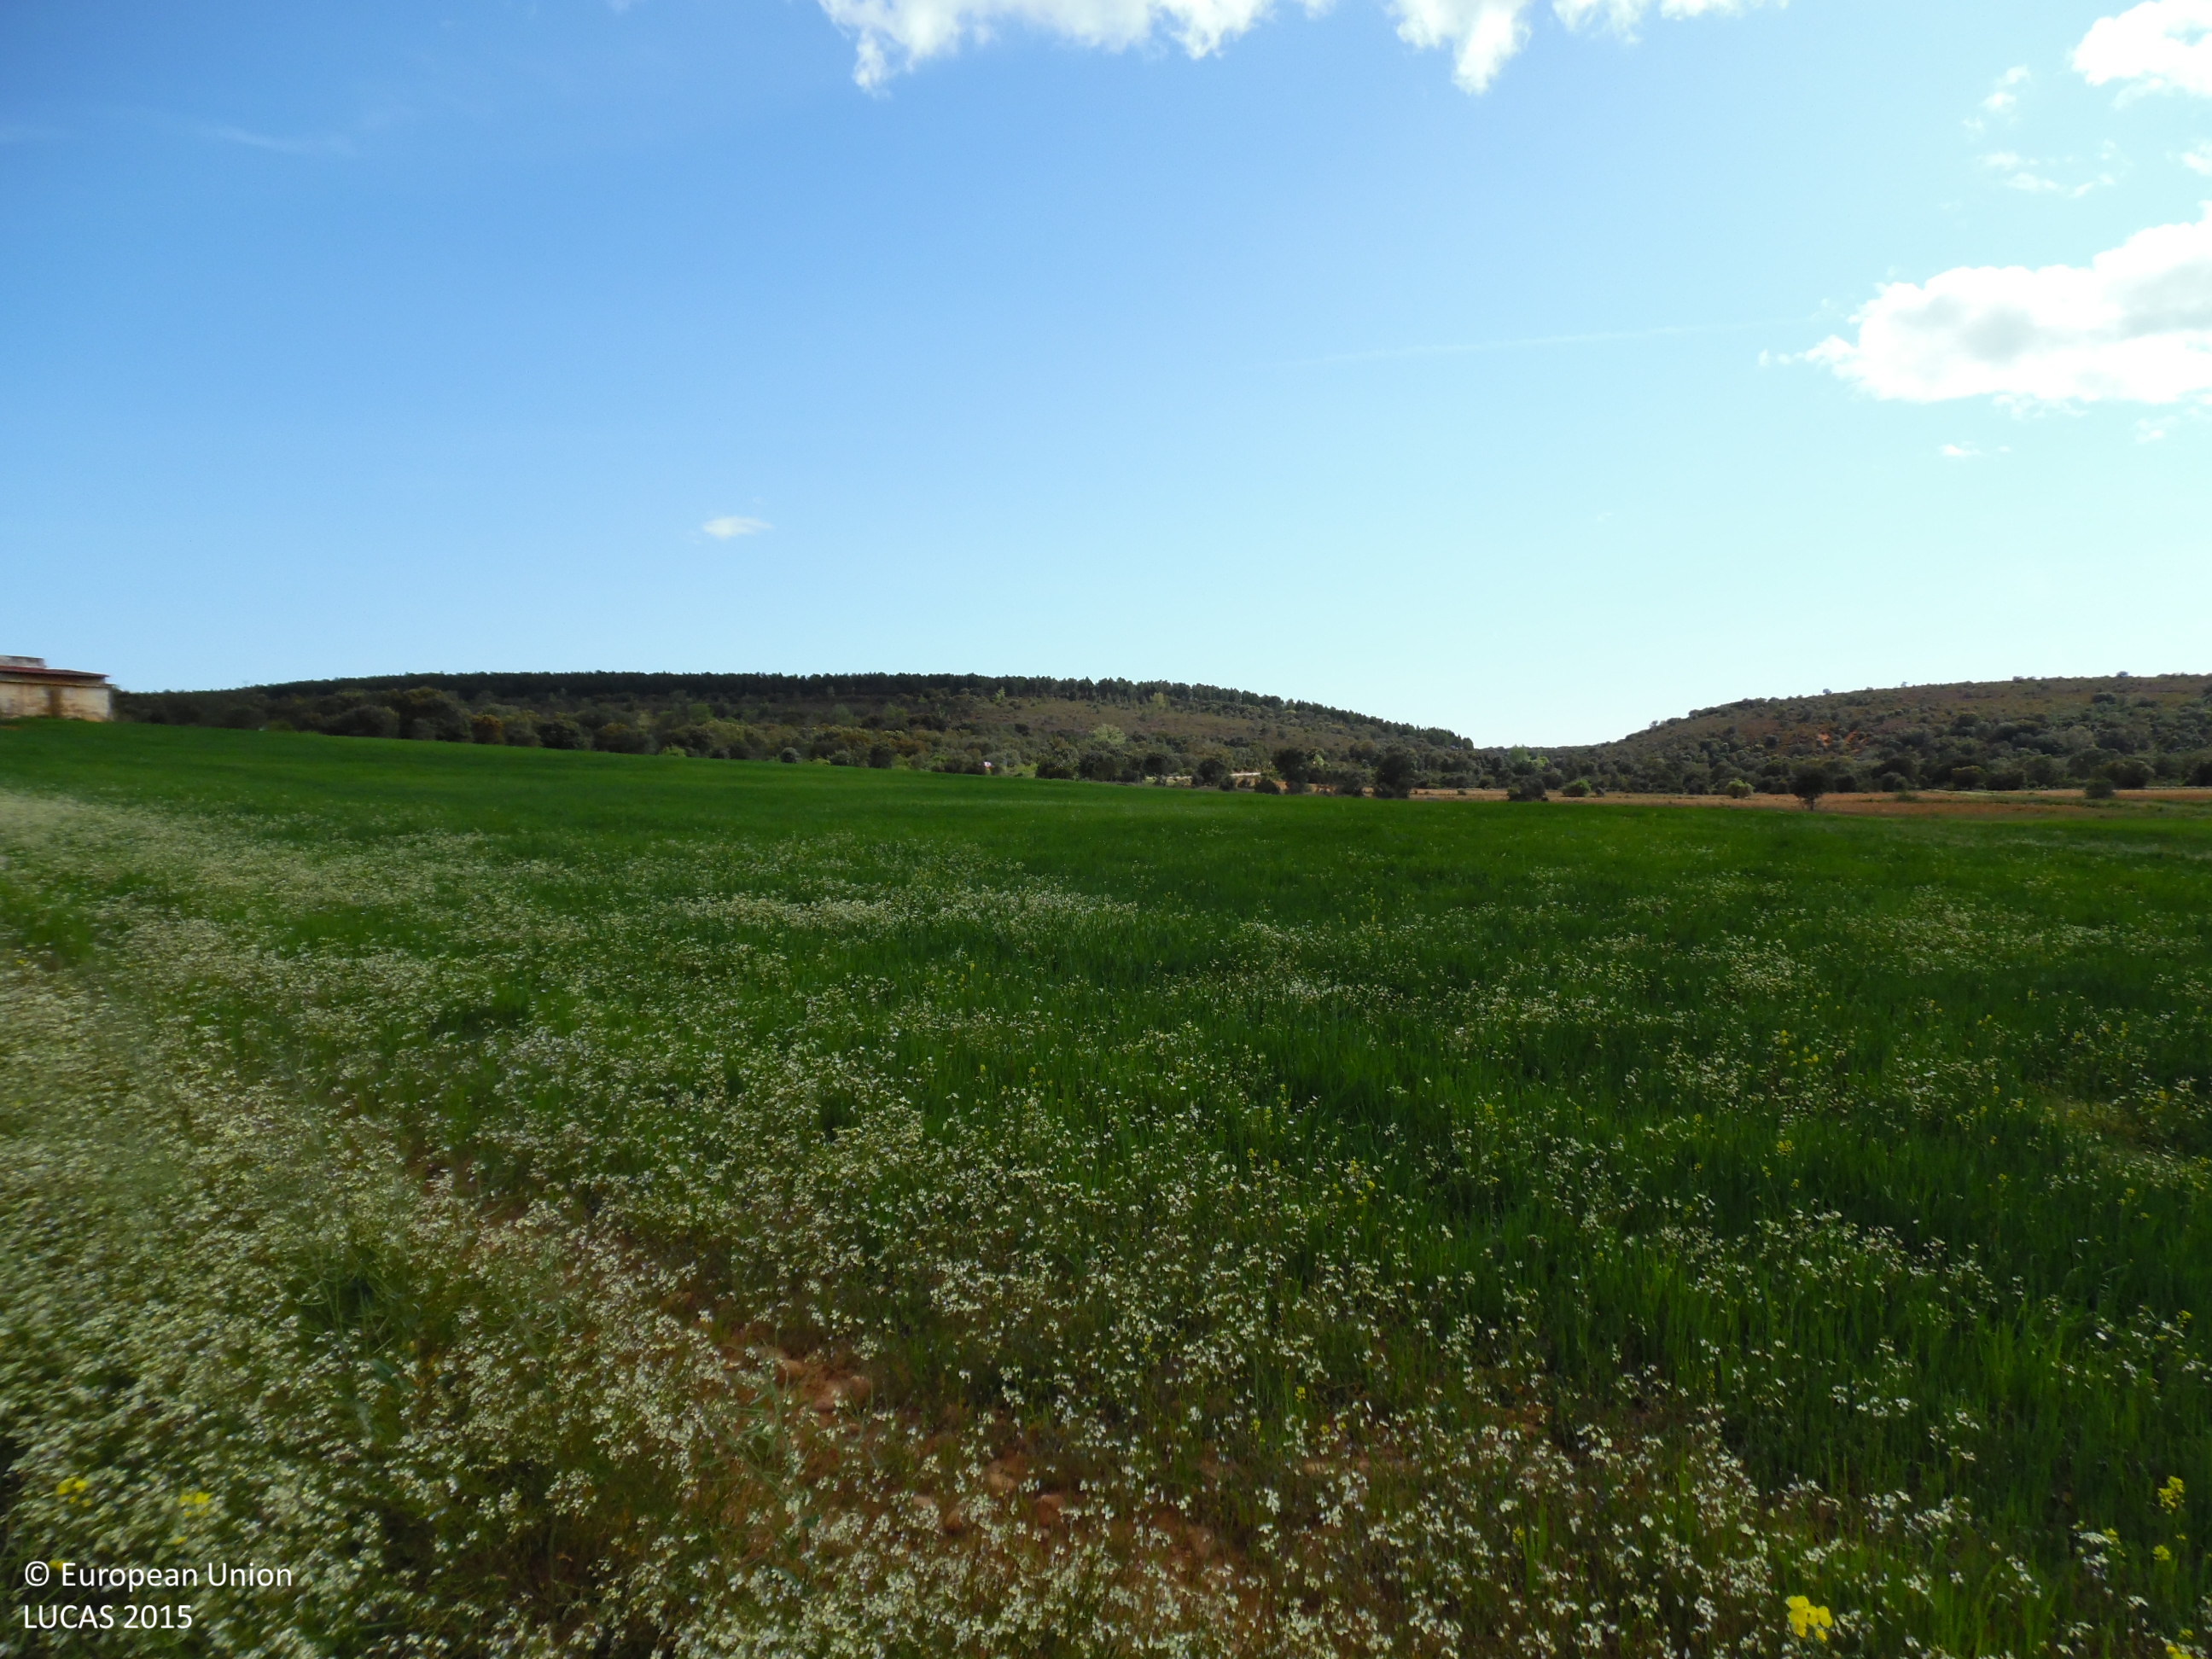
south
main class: Grassland
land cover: Spontaneously vegetated surfaces
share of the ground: > 75 %
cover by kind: herbaceous plants 100 %
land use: Fallow land
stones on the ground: 10 - 25 %
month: May
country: ES
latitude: 42.2556
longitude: -5.9930
